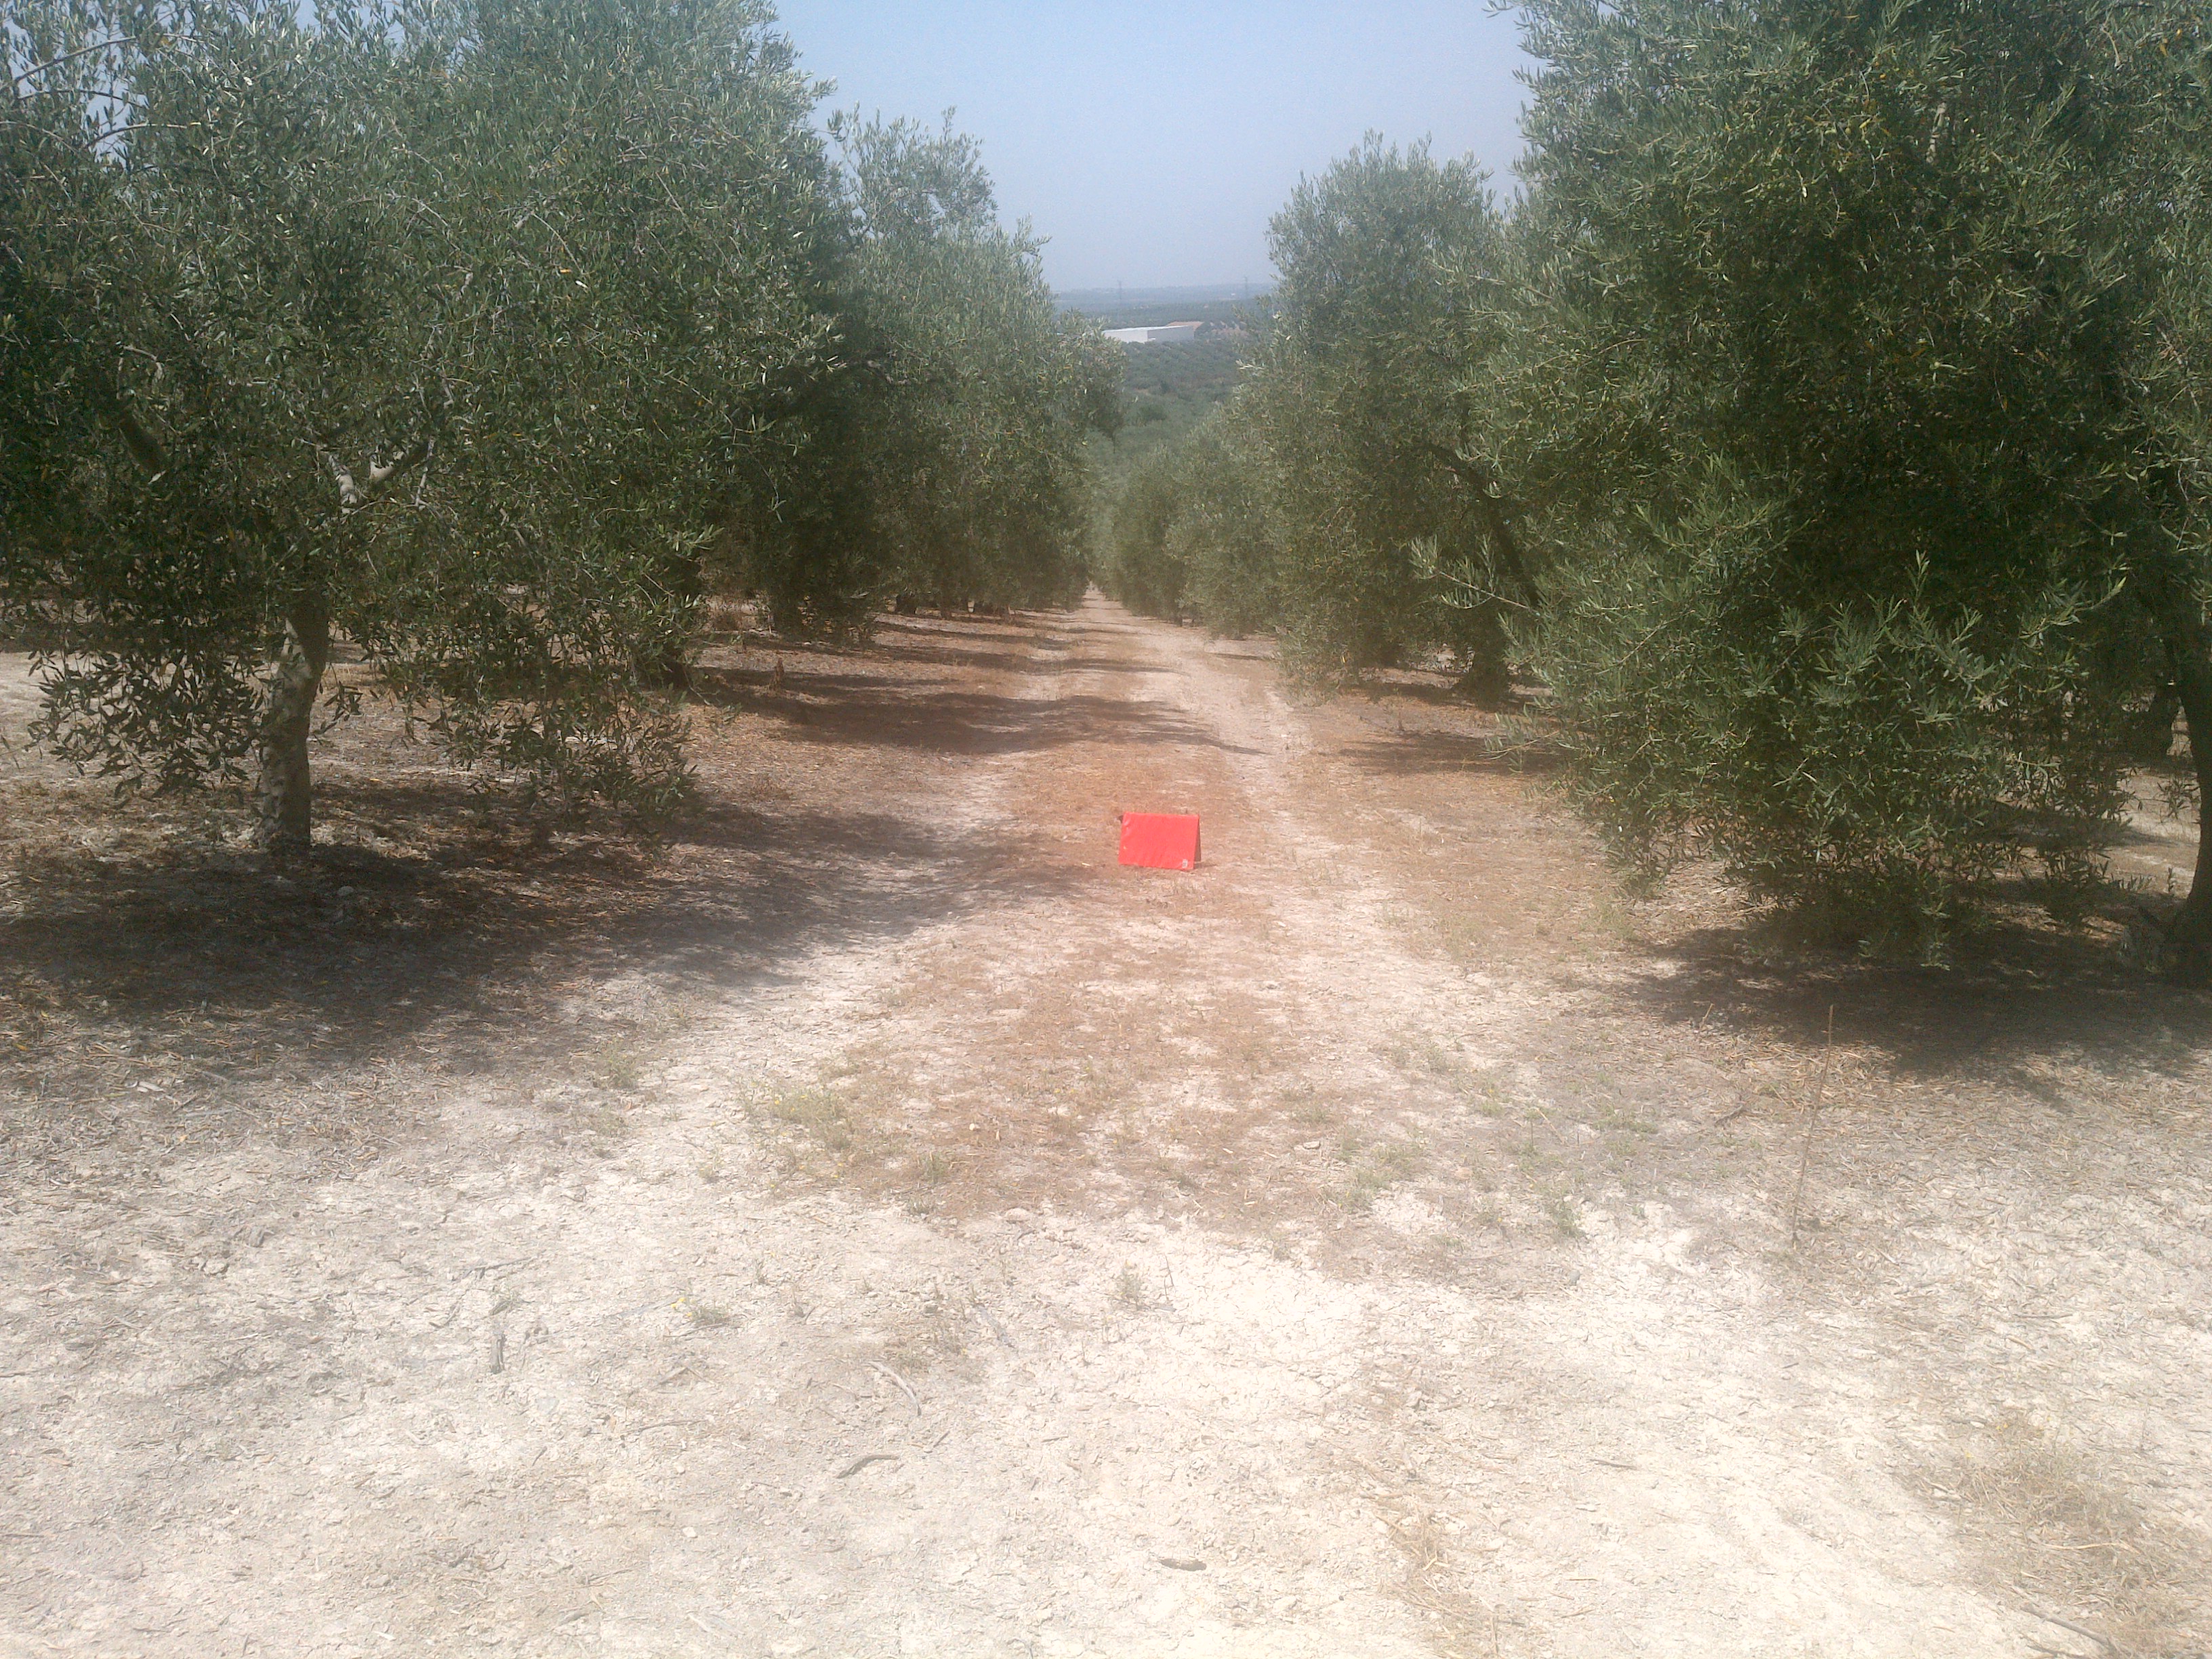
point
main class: Cropland
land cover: Olive groves
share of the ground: 50 - 75 %
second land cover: Other bare soil
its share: > 75 %
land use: Agriculture (excluding fallow land and kitchen gardens)
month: July
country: ES
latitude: 37.4807
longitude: -4.4673
